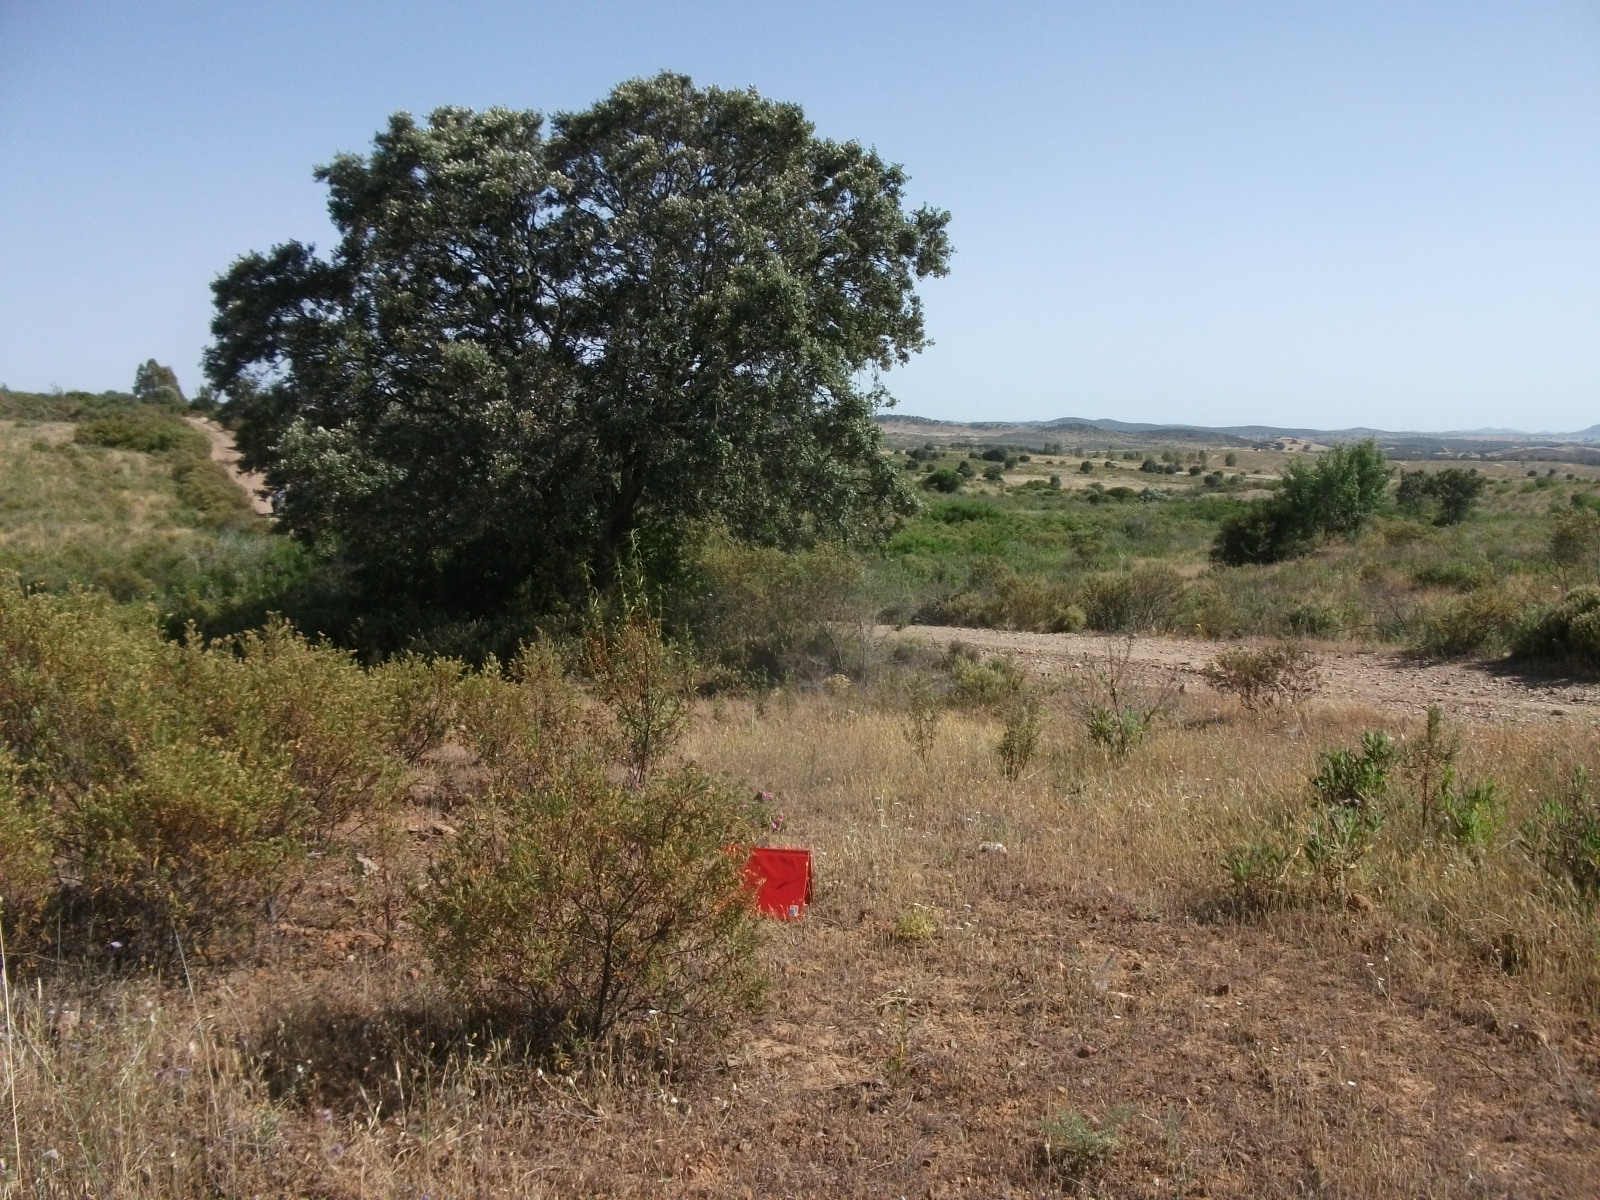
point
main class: Woodland
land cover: Broadleaved woodland
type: broadleaved evergreen forest
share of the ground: 10 - 25 %
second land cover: Spontaneously vegetated surfaces
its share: 50 - 75 %
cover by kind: shrubs 40 %, broadleaved forest trees 30 %, herbaceous plants 30 %
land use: Forestry
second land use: Agriculture (excluding fallow land and kitchen gardens)
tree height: < 5 m
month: May
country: ES
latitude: 37.7547
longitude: -7.1109
